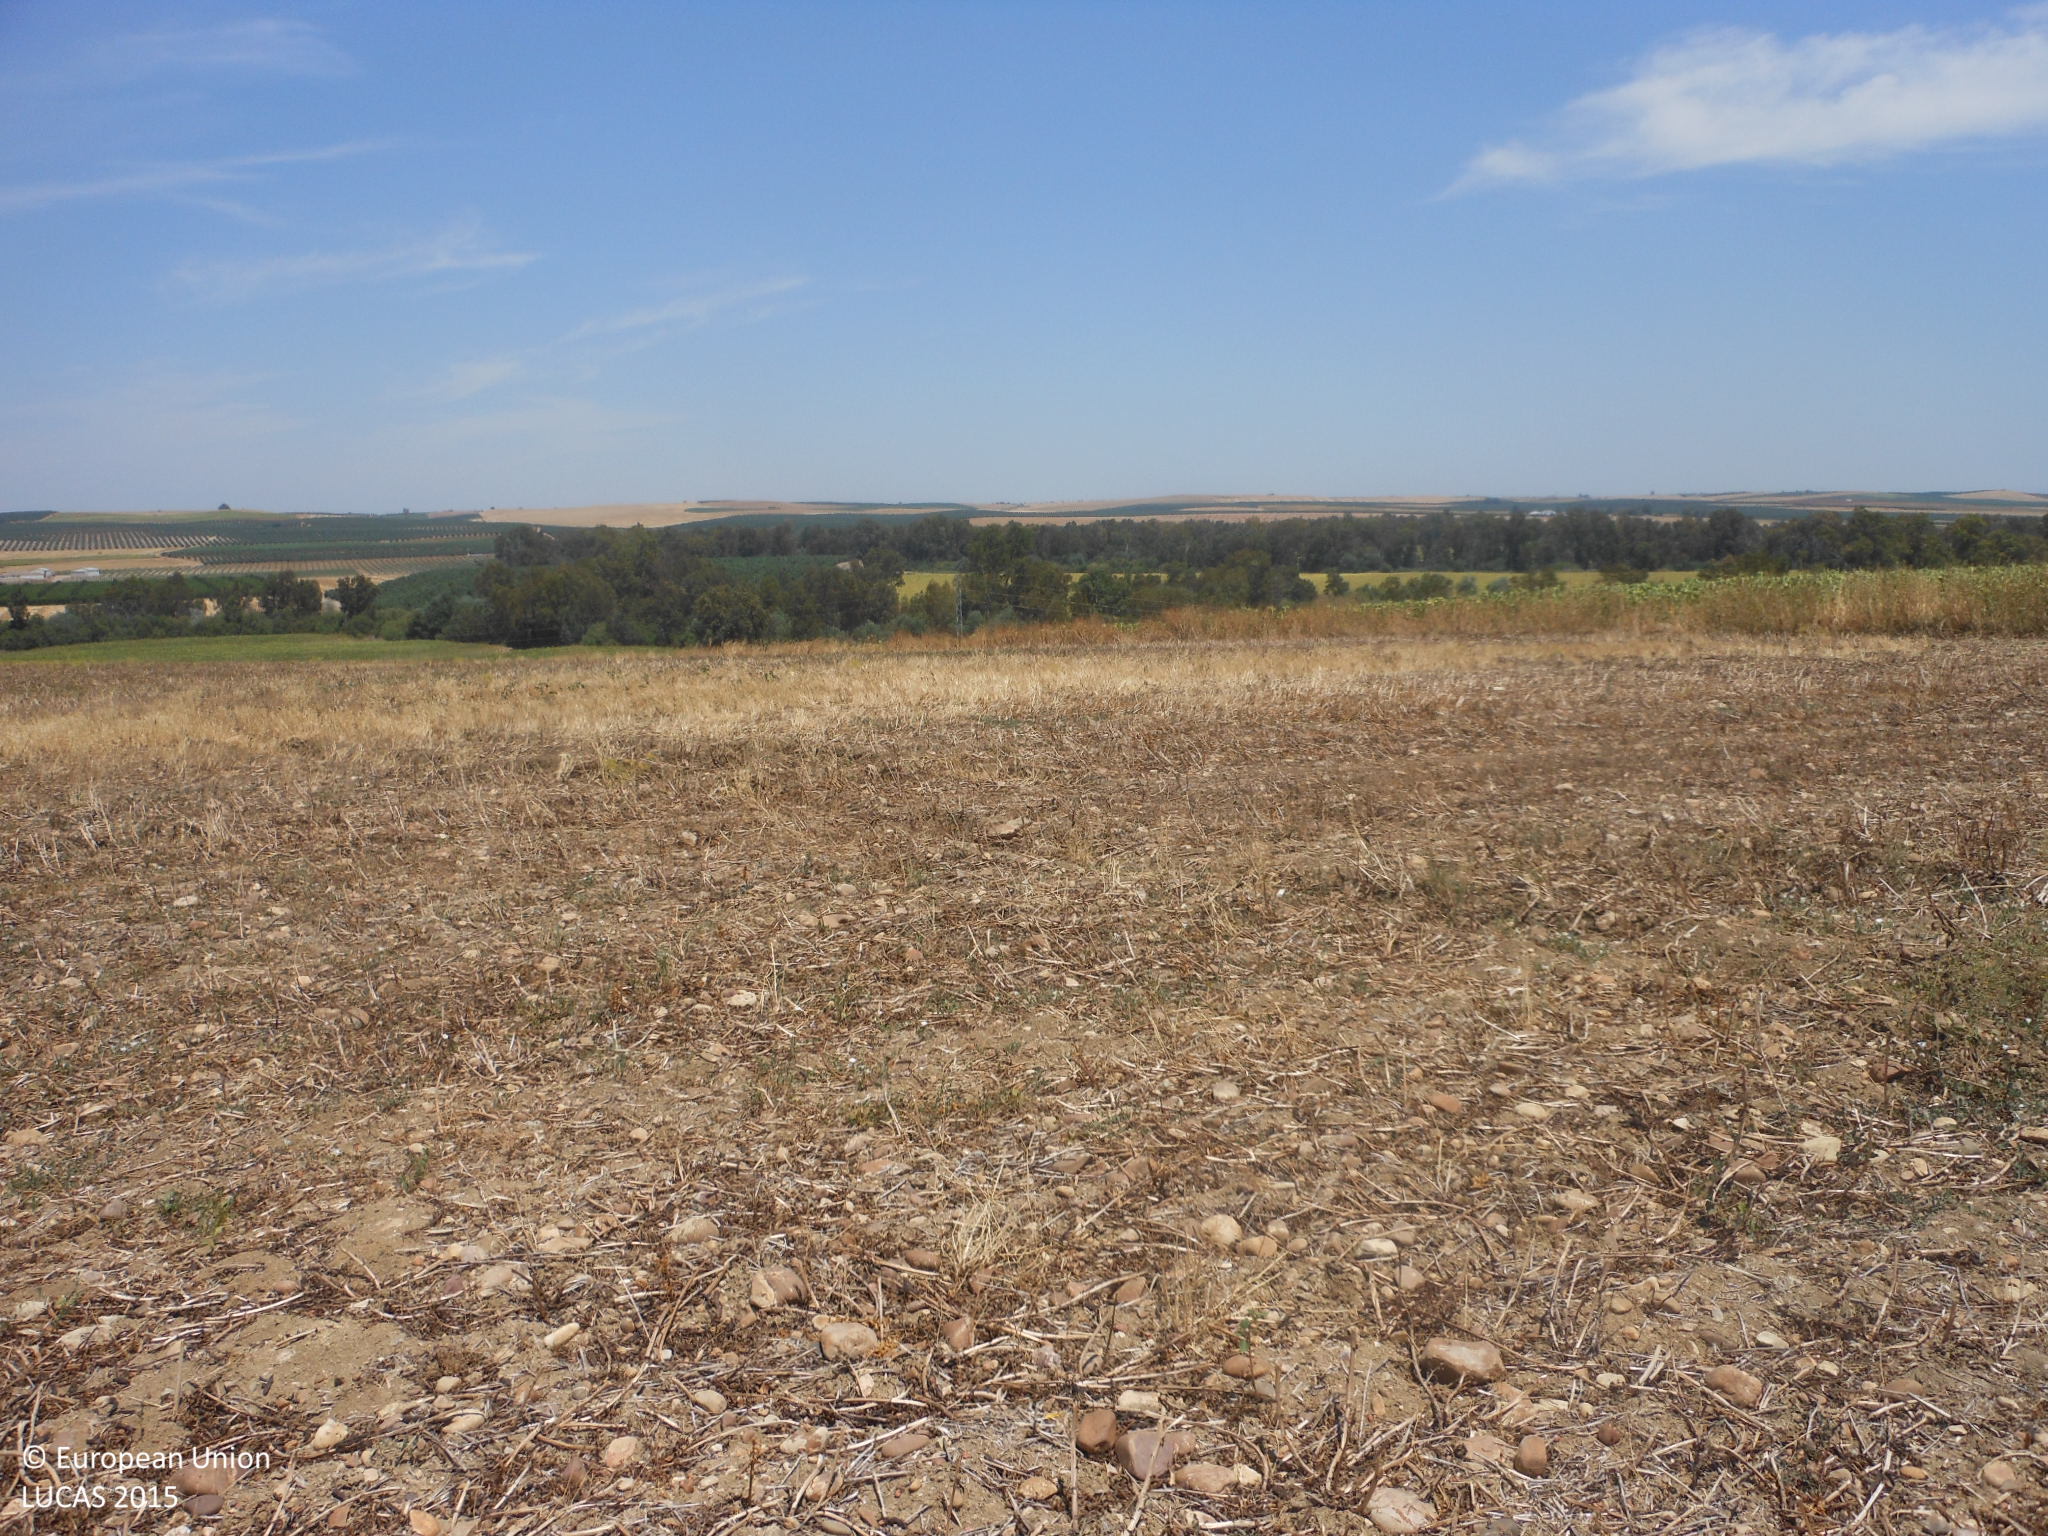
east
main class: Cropland
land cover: Dry pulses
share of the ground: < 10 %
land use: Agriculture (excluding fallow land and kitchen gardens)
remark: Harvested field
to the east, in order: Dry pulses; Grass margins; Sunflower; Electric lines; Spontaneously vegetated surfaces; Tracks; Sunflower
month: June
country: ES
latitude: 37.6140
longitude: -5.1386
